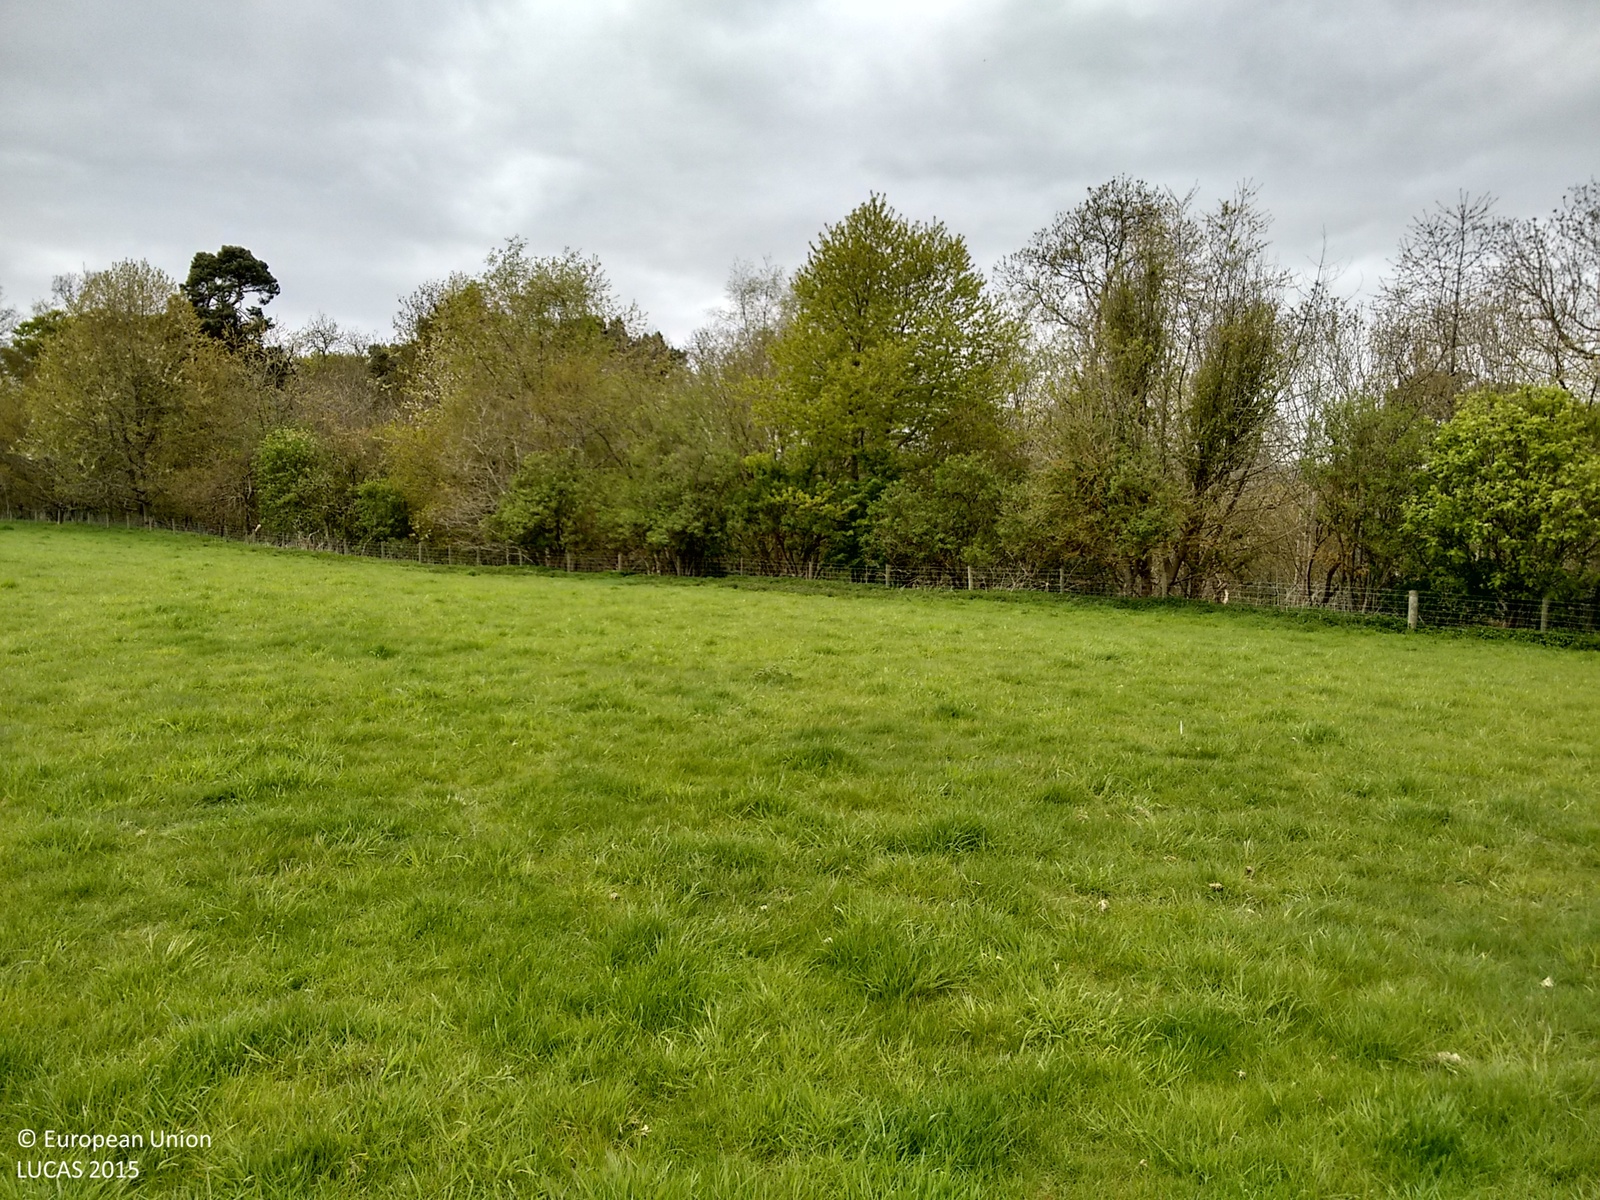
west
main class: Grassland
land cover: Grassland without tree/shrub cover
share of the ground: > 75 %
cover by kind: herbaceous plants 100 %
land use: Agriculture (excluding fallow land and kitchen gardens)
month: May
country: GB
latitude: 55.8534
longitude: -3.1541
